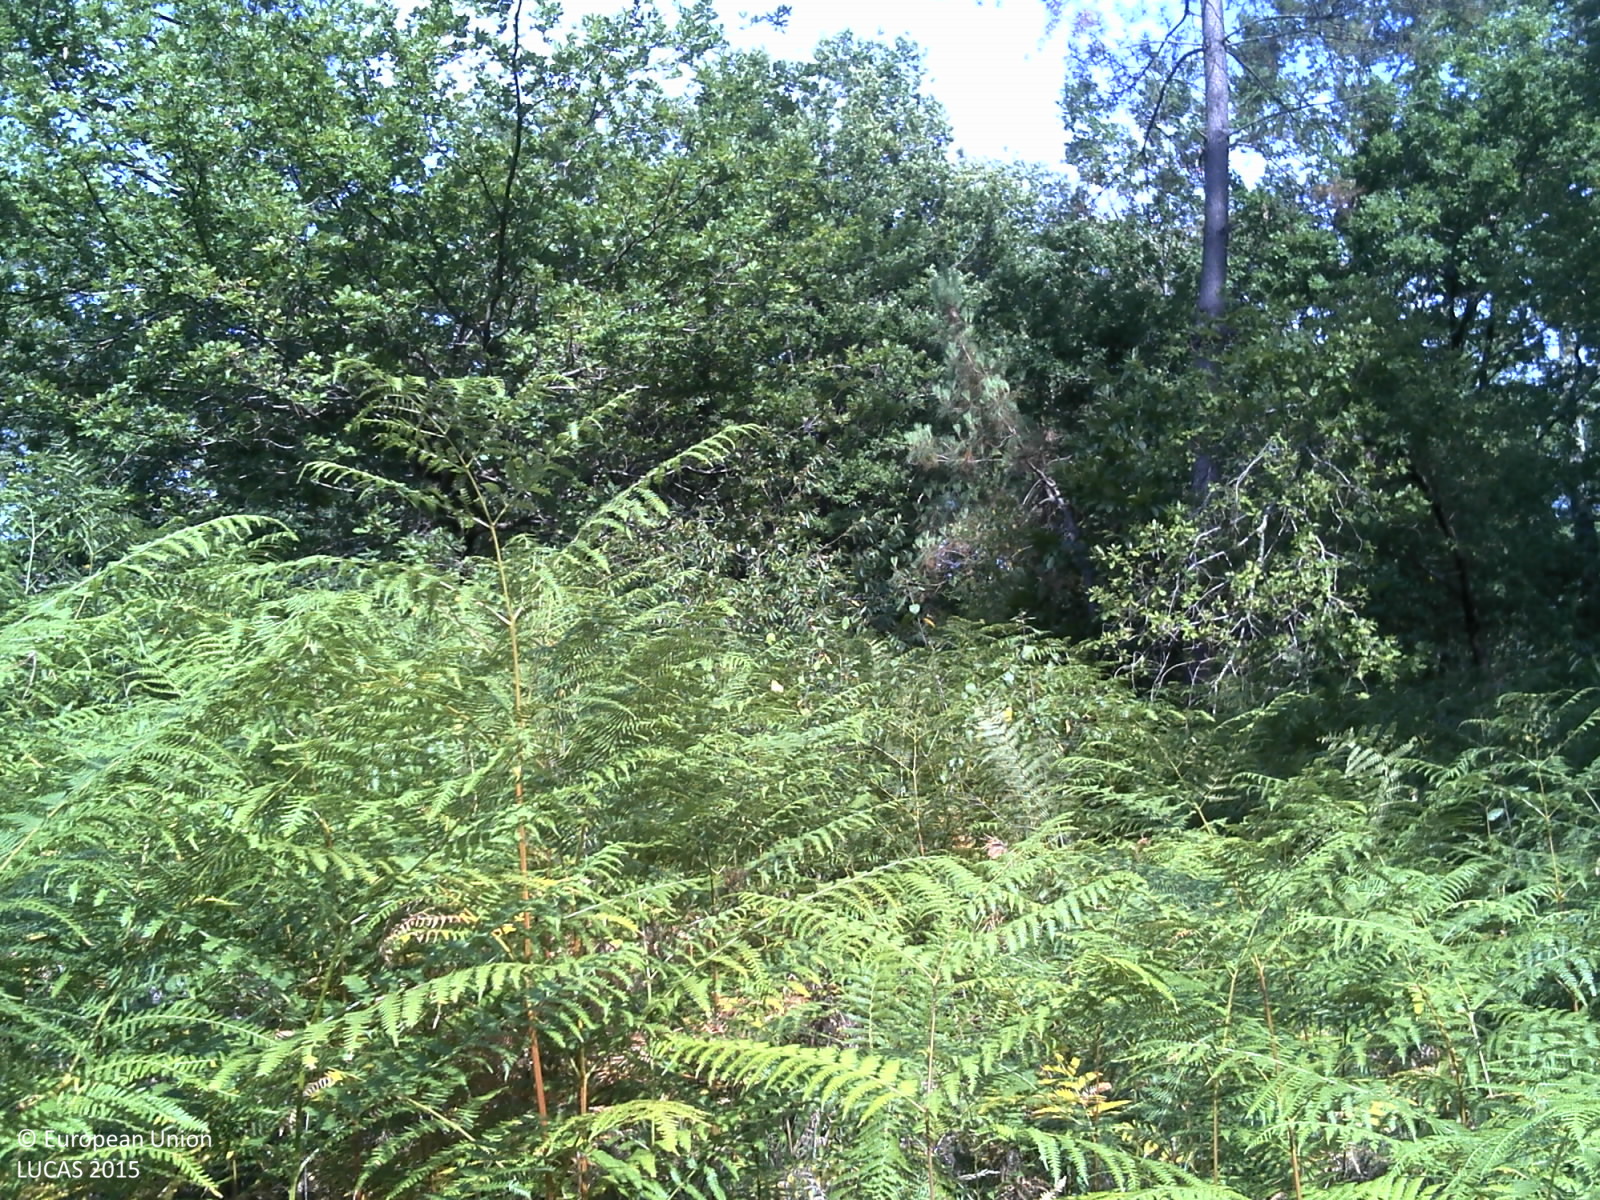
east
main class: Woodland
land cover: Pine dominated coniferous woodland
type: exotic forest
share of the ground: > 75 %
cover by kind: coniferous forest trees 70 %, shrubs 25 %, herbaceous plants 5 %
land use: Forestry
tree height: > 5 m
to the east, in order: Pine dominated coniferous woodland; Tracks; Pine dominated coniferous woodland; Grass margins; Tracks; Pine dominated coniferous woodland; Tracks; Lines of trees; Tracks; Ditches and canals; Pine dominated mixed woodland; Paved roads, cycling and walking lanes; Broadleaved woodland
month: July
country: FR
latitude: 44.7267
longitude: -0.6624
